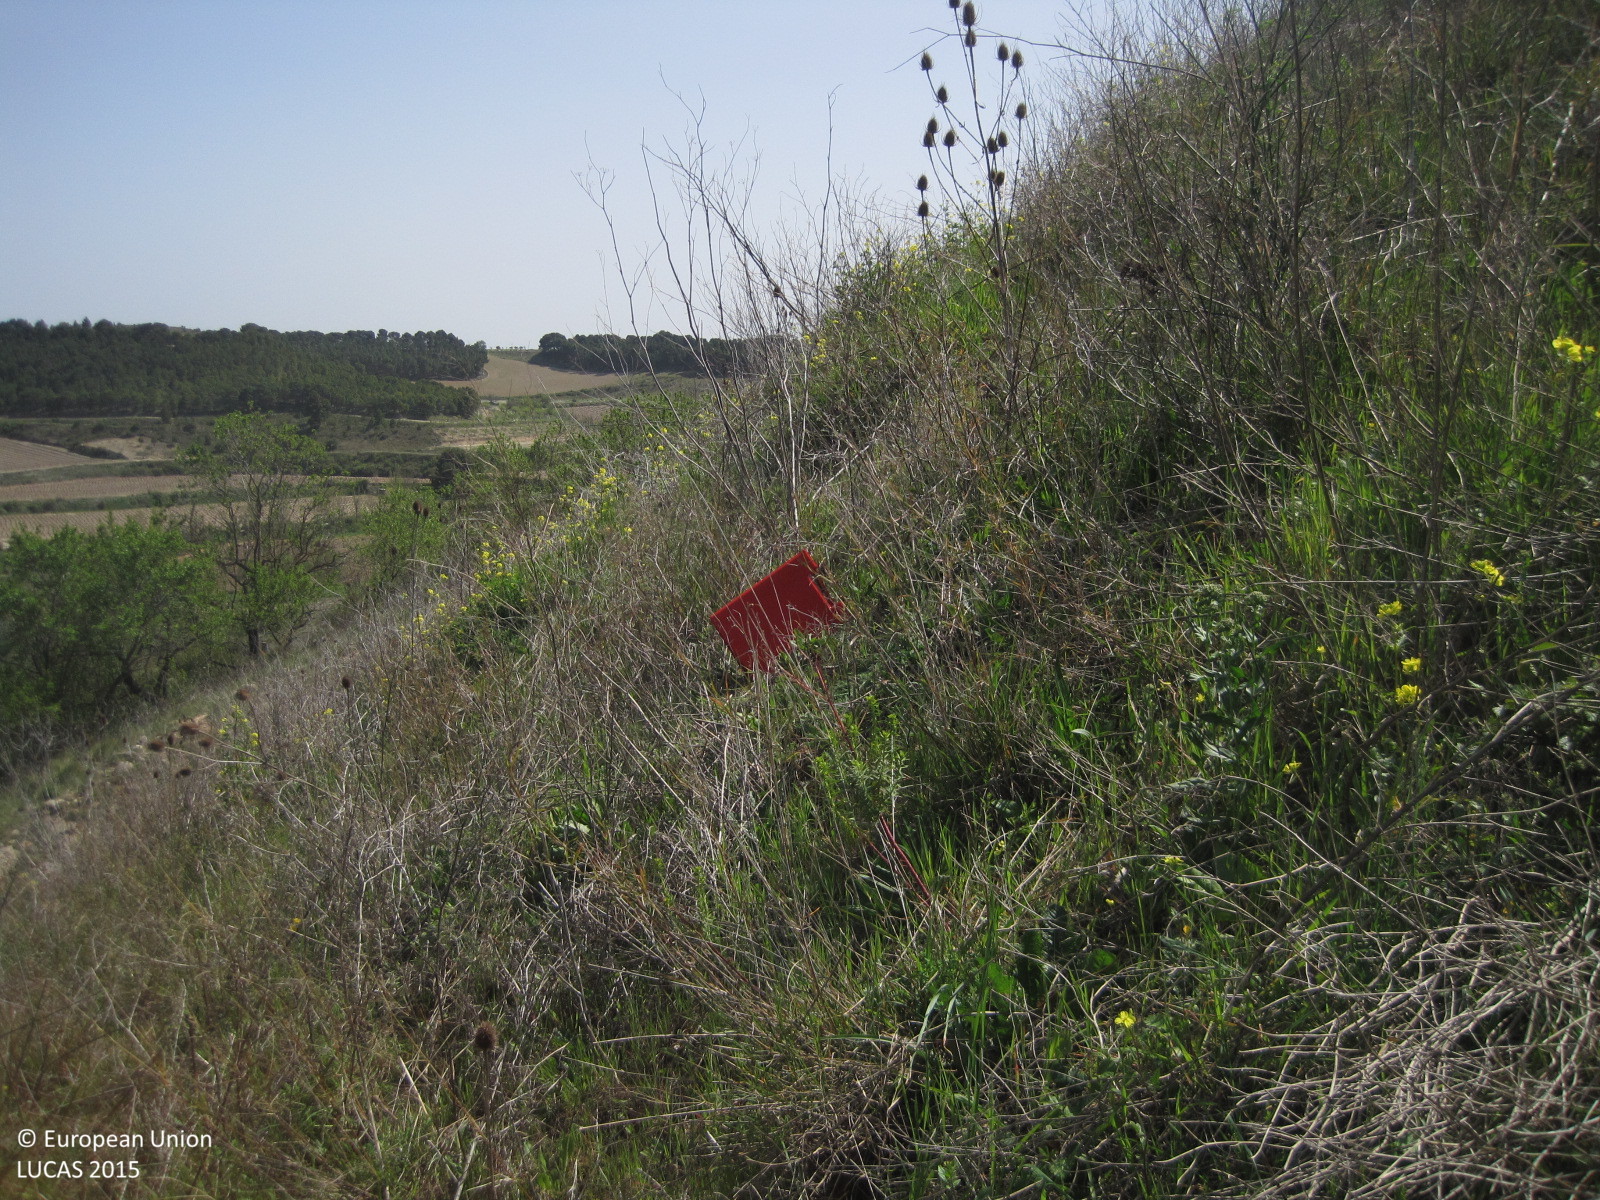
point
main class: Grassland
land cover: Grassland without tree/shrub cover
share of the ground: > 75 %
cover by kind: herbaceous plants 90 %, shrubs 5 %, consolidated bare surface 5 %
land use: Semi-natural and natural areas not in use
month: April
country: ES
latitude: 42.5304
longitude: -2.3773
